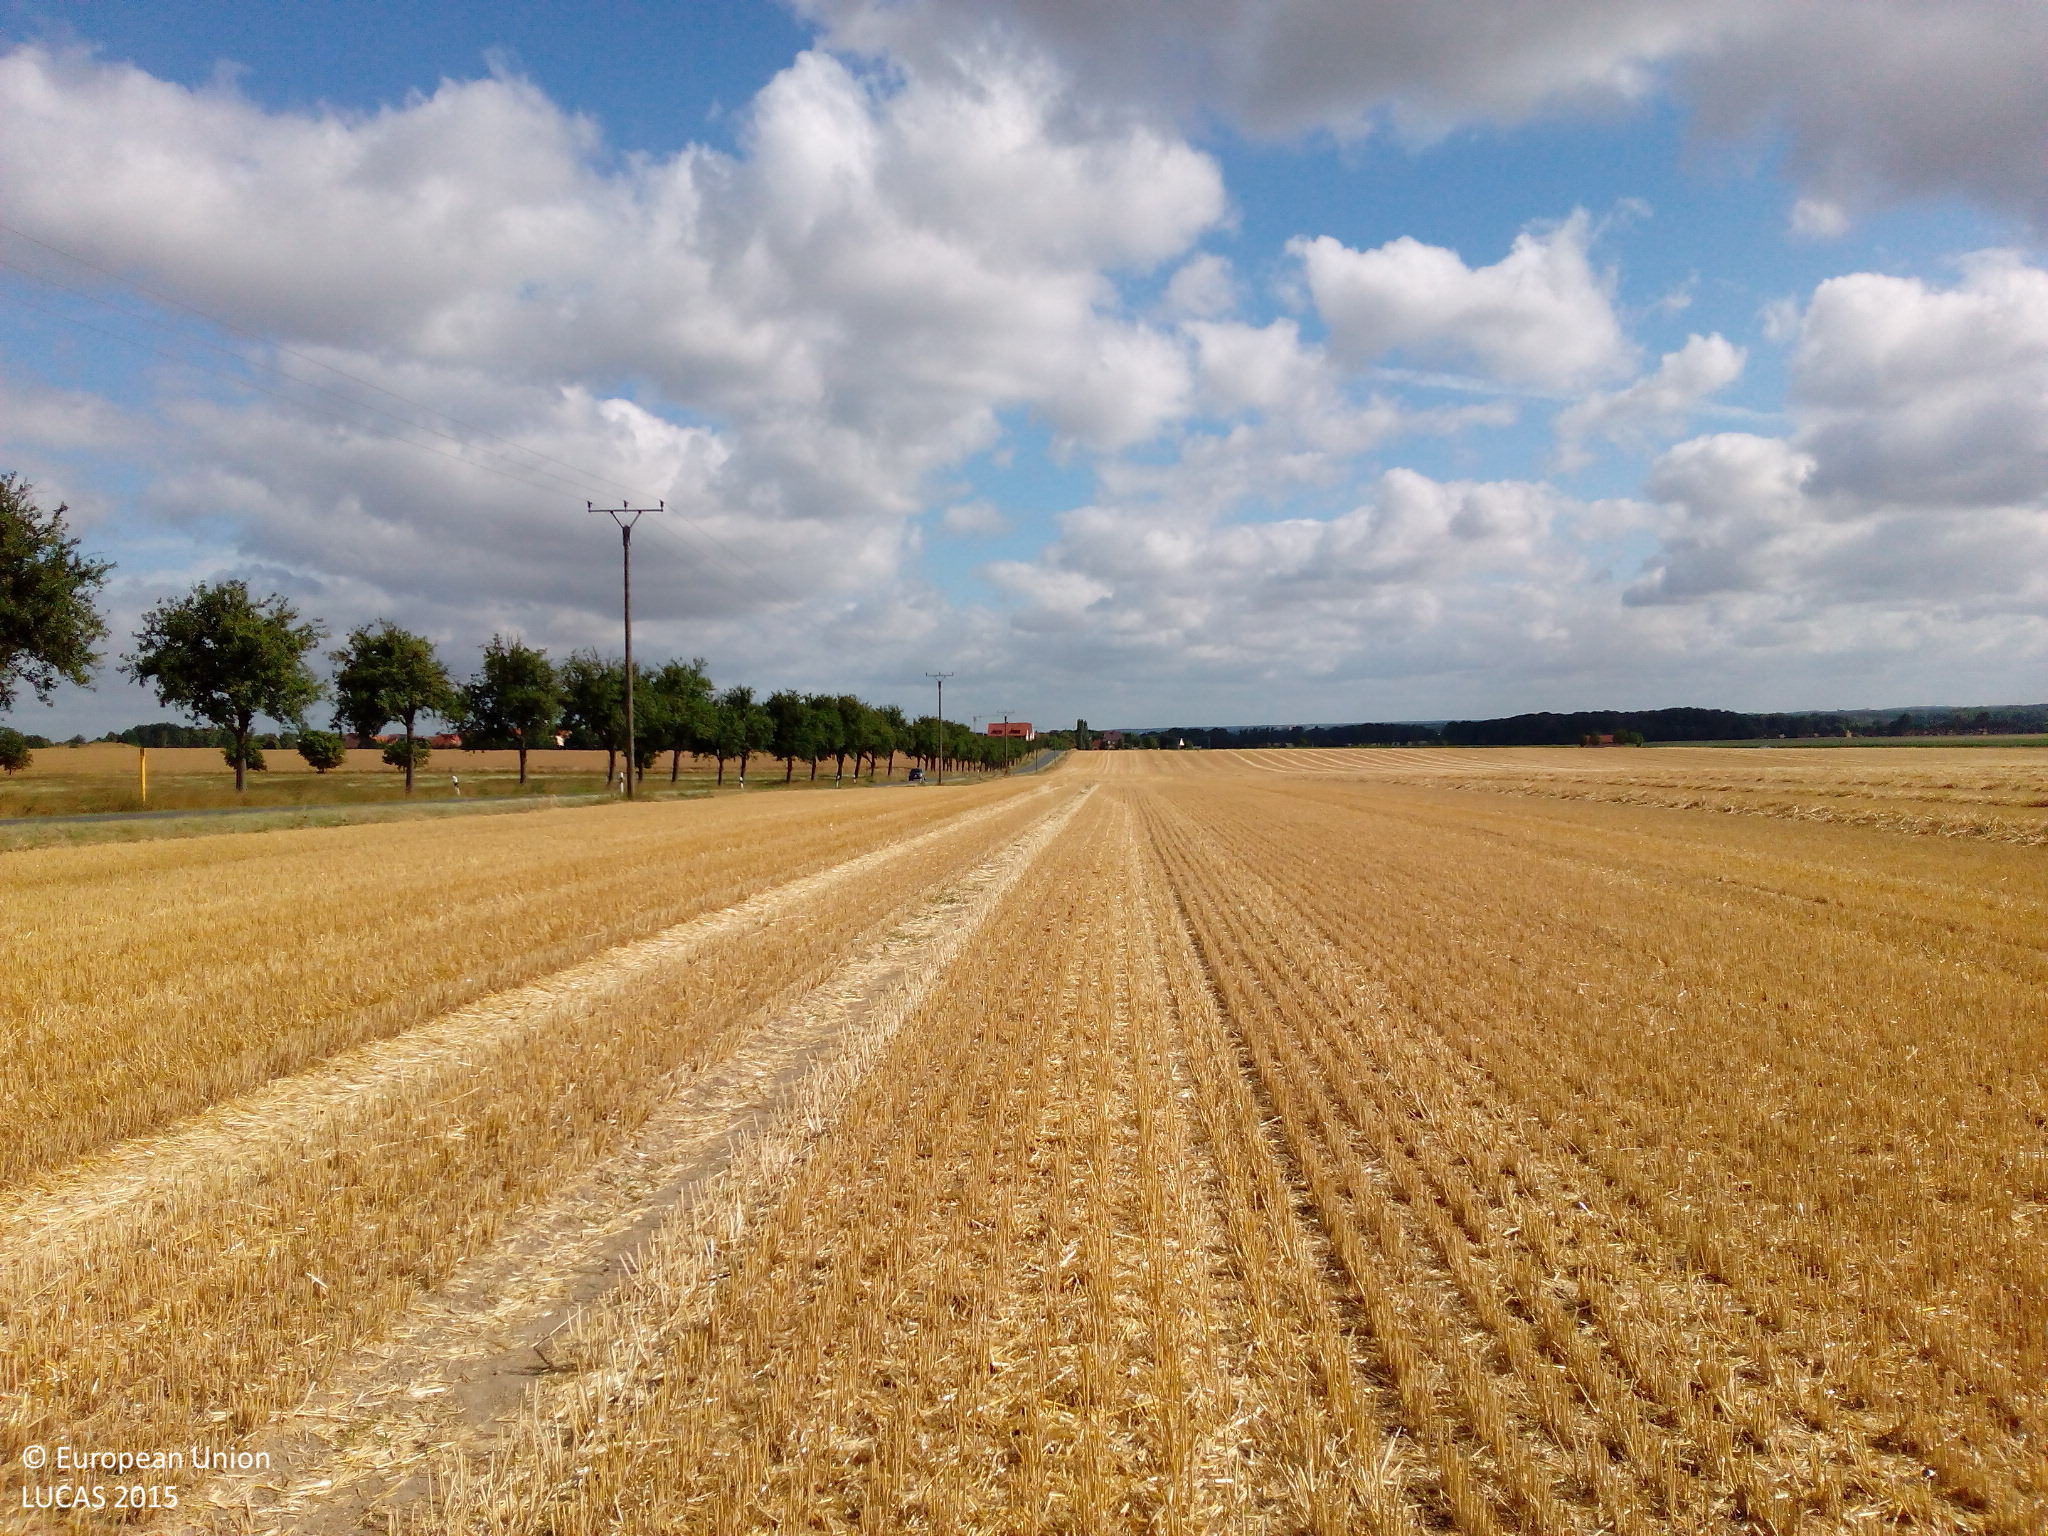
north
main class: Cropland
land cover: Durum wheat
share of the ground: 25 - 50 %
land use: Agriculture (excluding fallow land and kitchen gardens)
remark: Harvested field
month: July
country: DE
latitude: 51.2713
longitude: 12.5368
